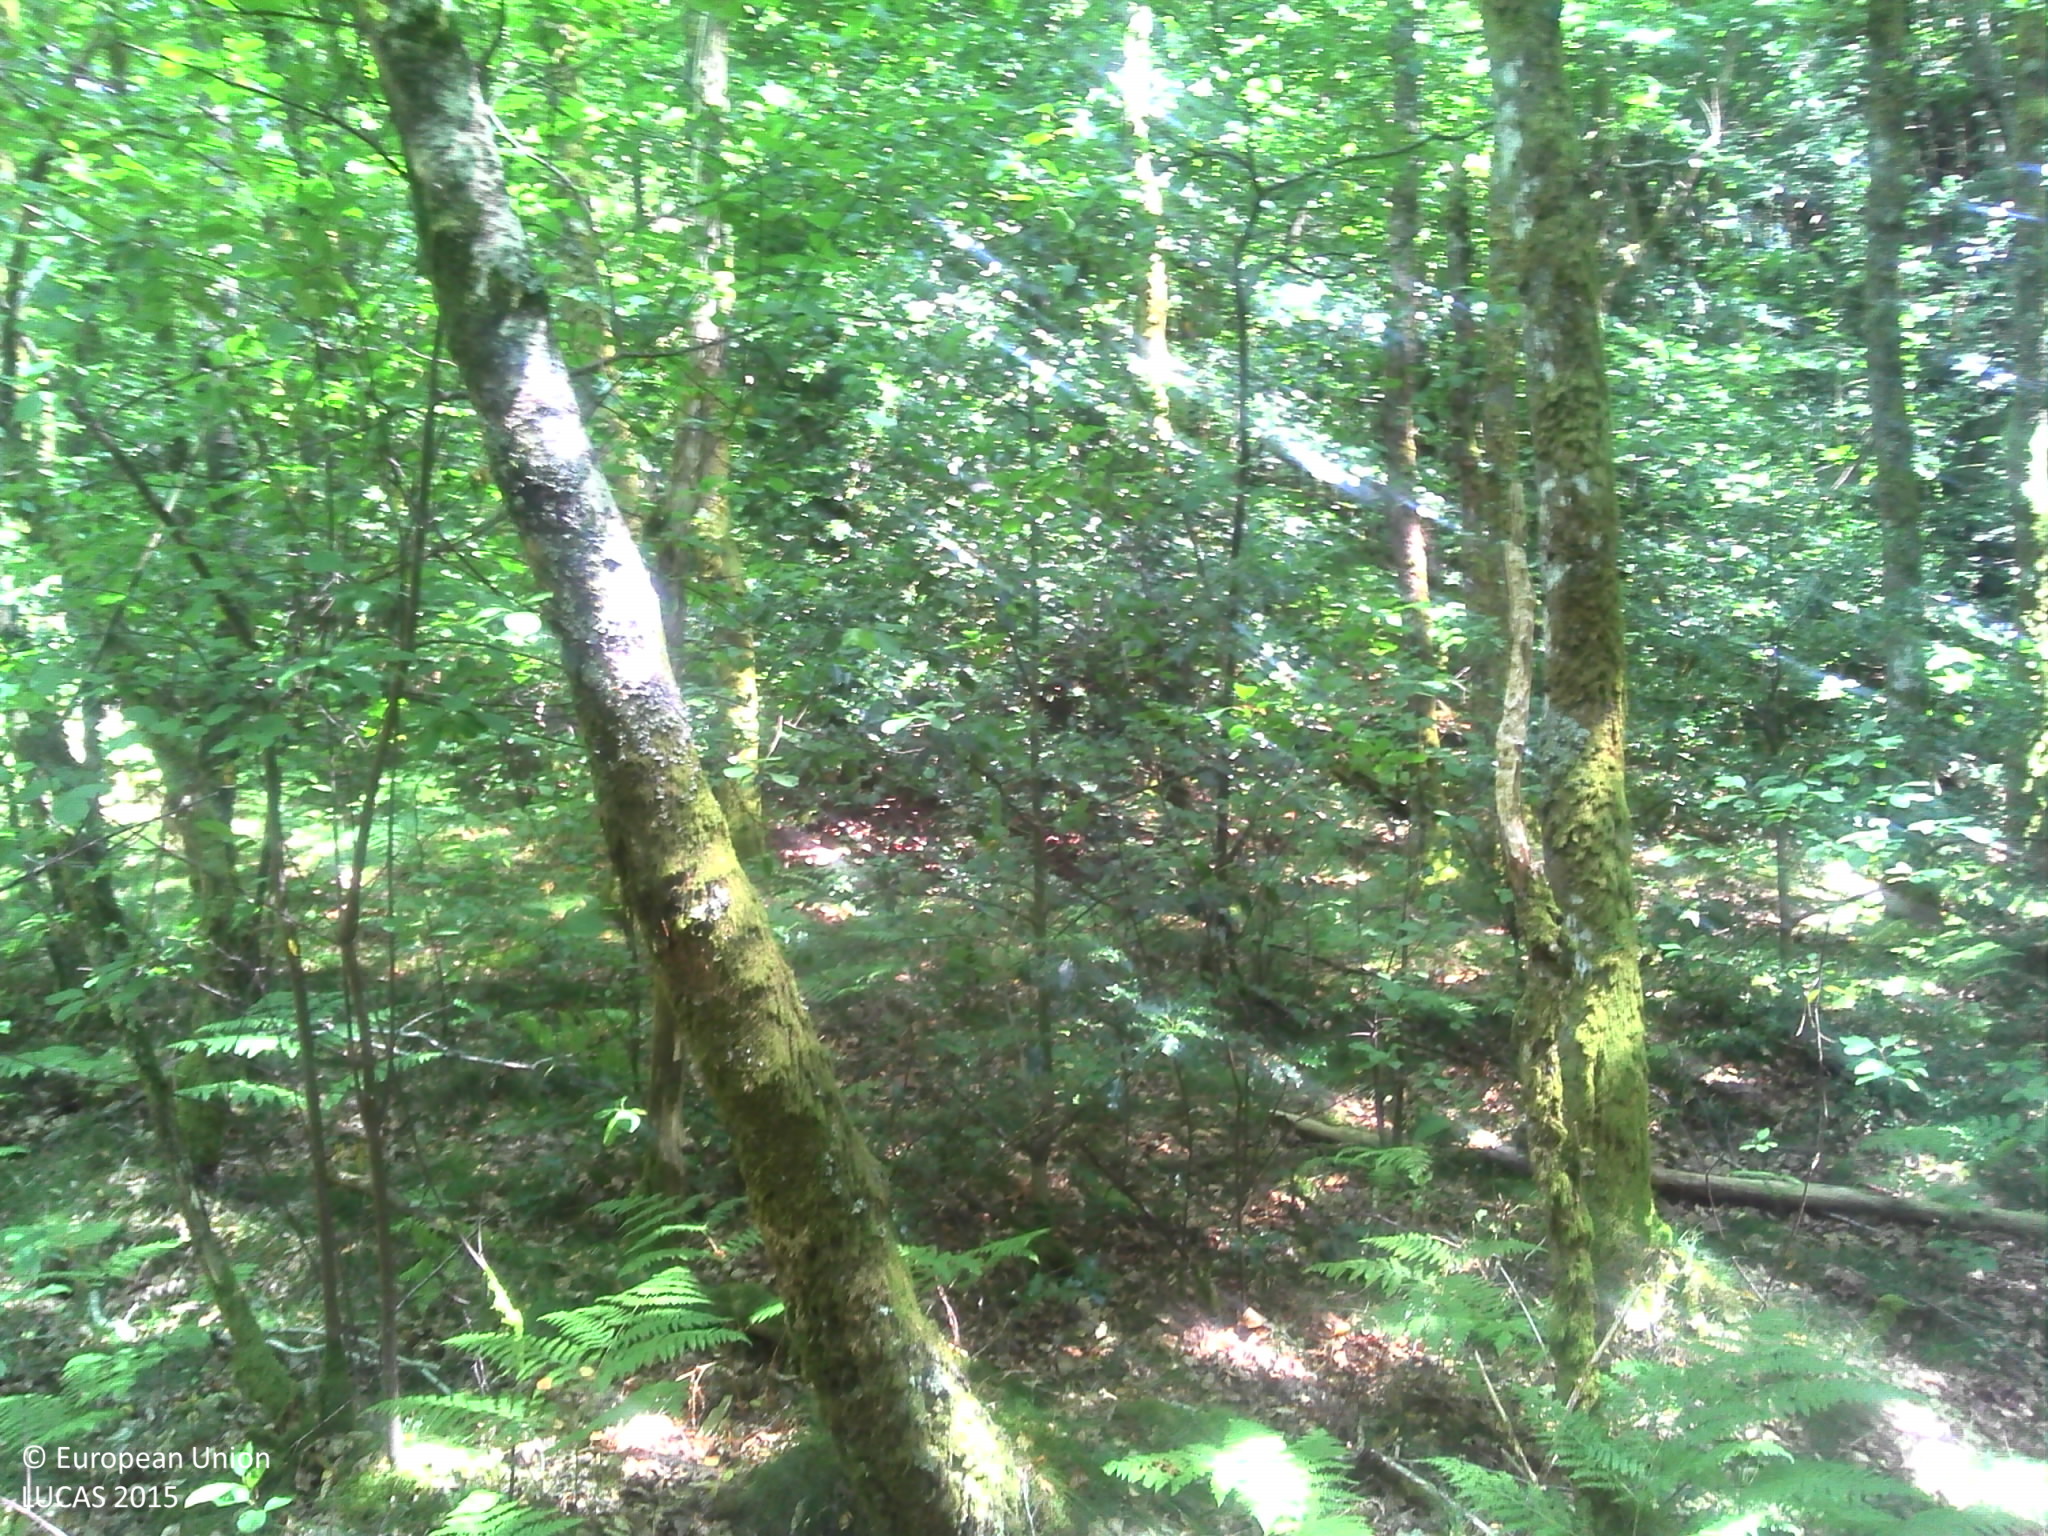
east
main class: Woodland
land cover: Broadleaved woodland
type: acidophilous oak and oak-birch forest
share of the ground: > 75 %
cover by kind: broadleaved forest trees 85 %, lichens and mosses 10 %, herbaceous plants 5 %
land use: Forestry
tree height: > 5 m
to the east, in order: Broadleaved woodland; Spruce dominated coniferous woodland; Broadleaved woodland; Spruce dominated mixed woodland; Broadleaved woodland
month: July
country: FR
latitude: 46.0548
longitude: 1.5775
